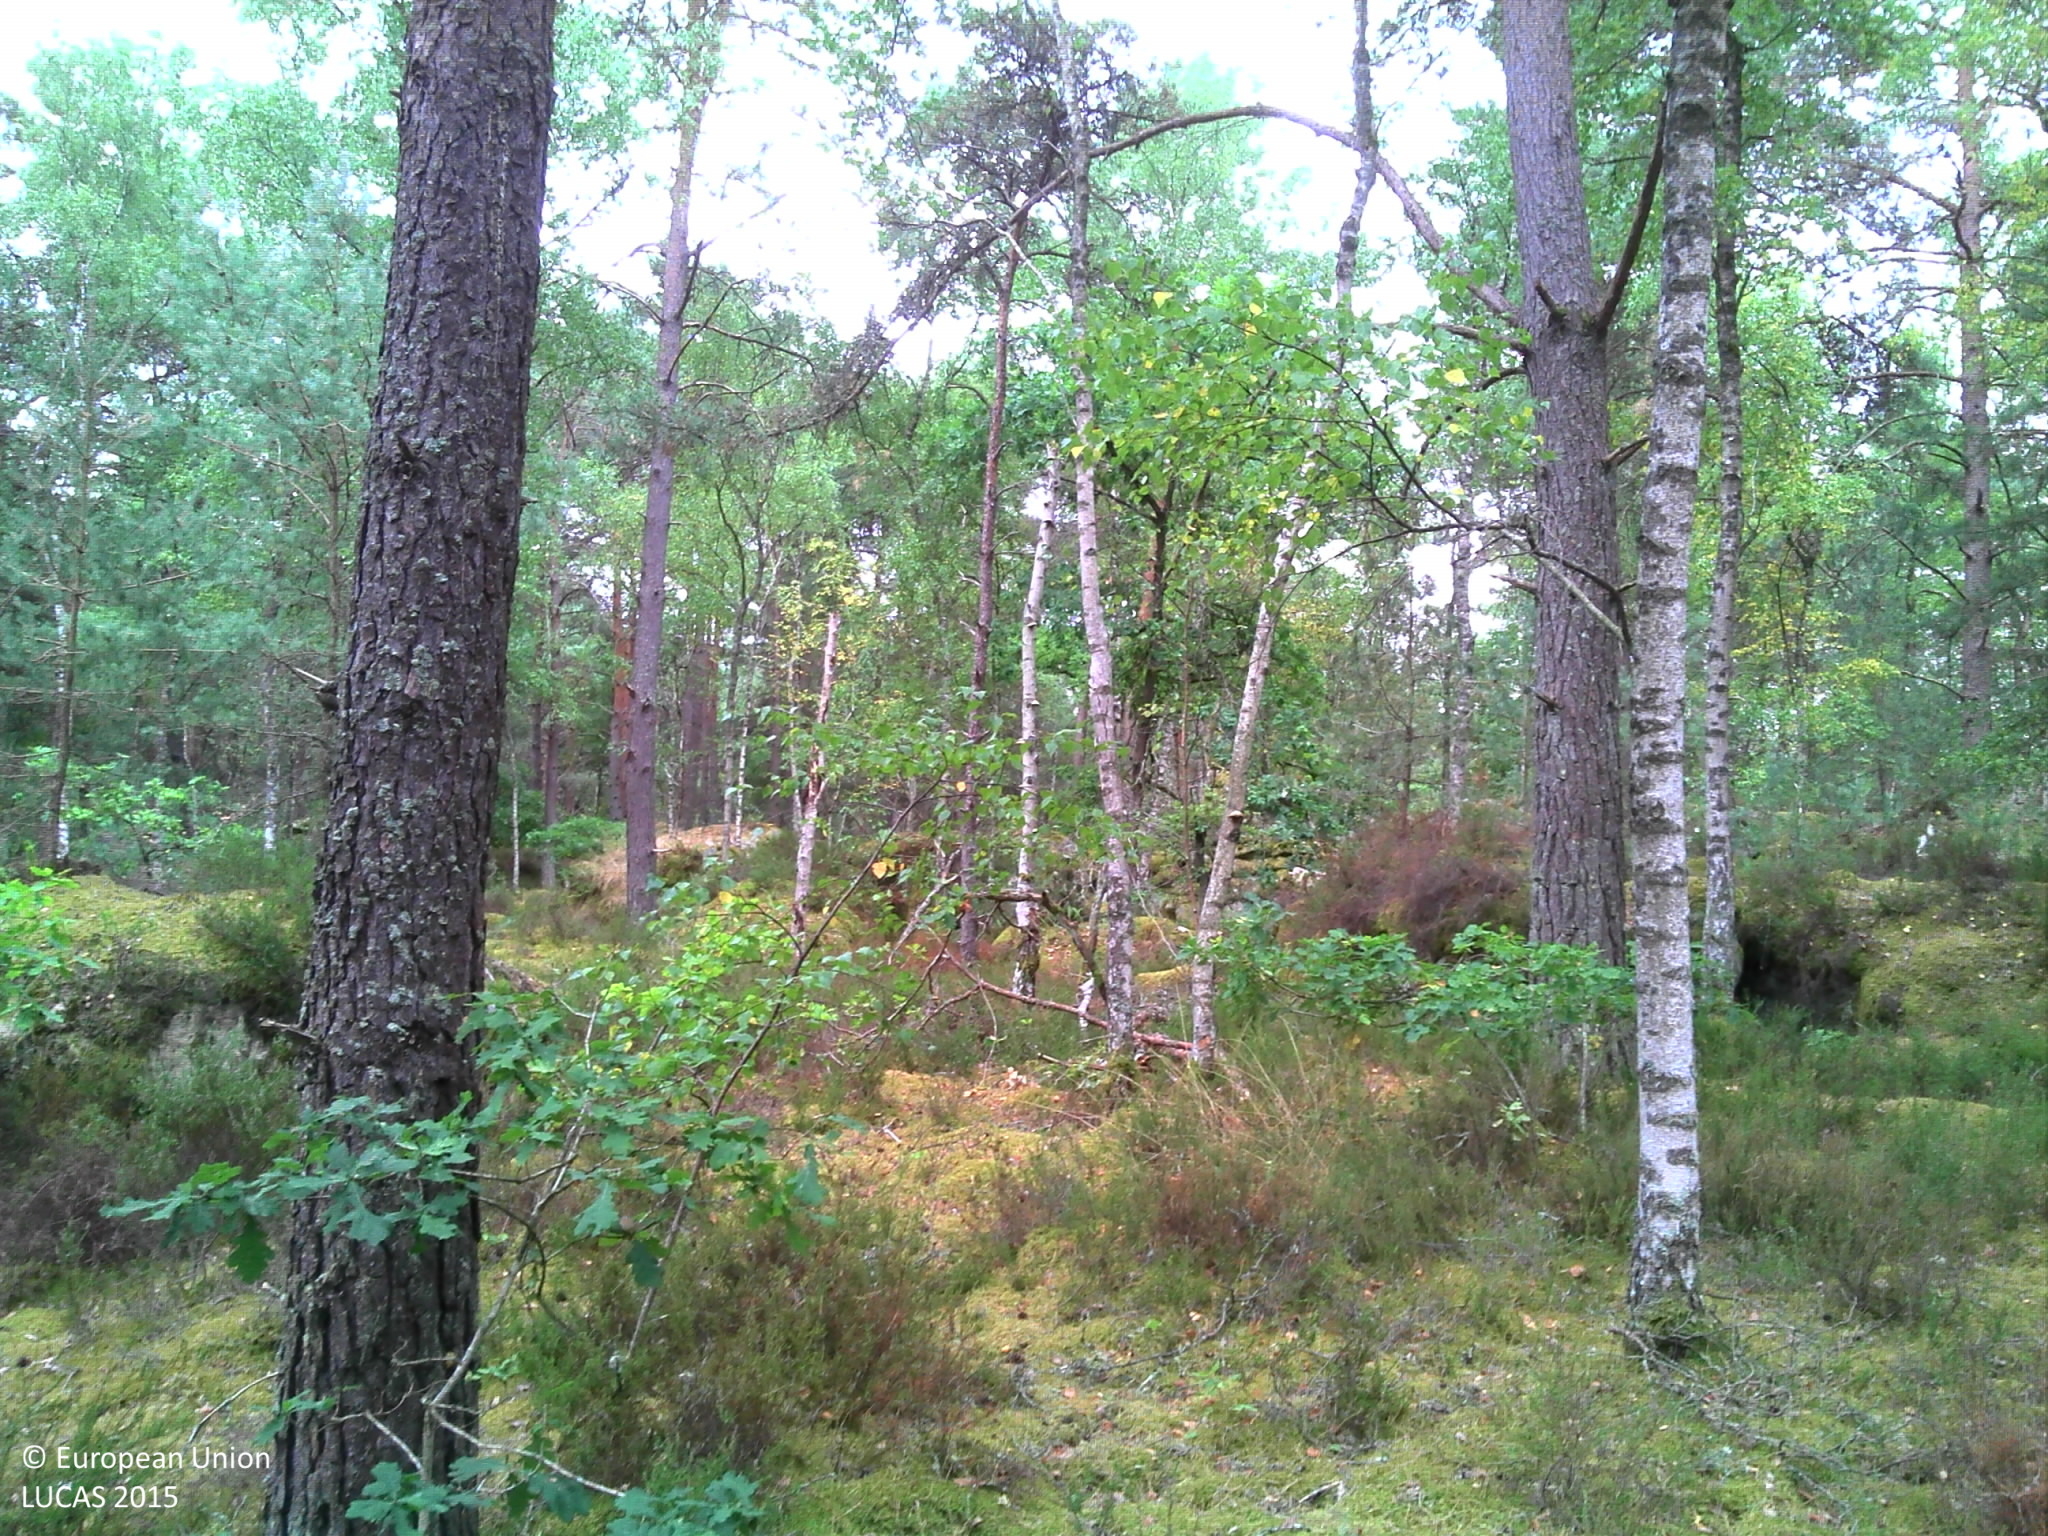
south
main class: Woodland
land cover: Pine dominated mixed woodland
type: non-riverine alder, birch or aspen forest
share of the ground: > 75 %
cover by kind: lichens and mosses 40 %, coniferous forest trees 30 %, shrubs 20 %, broadleaved forest trees 10 %
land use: Forestry
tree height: > 5 m
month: August
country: FR
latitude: 48.3671
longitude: 2.5251
